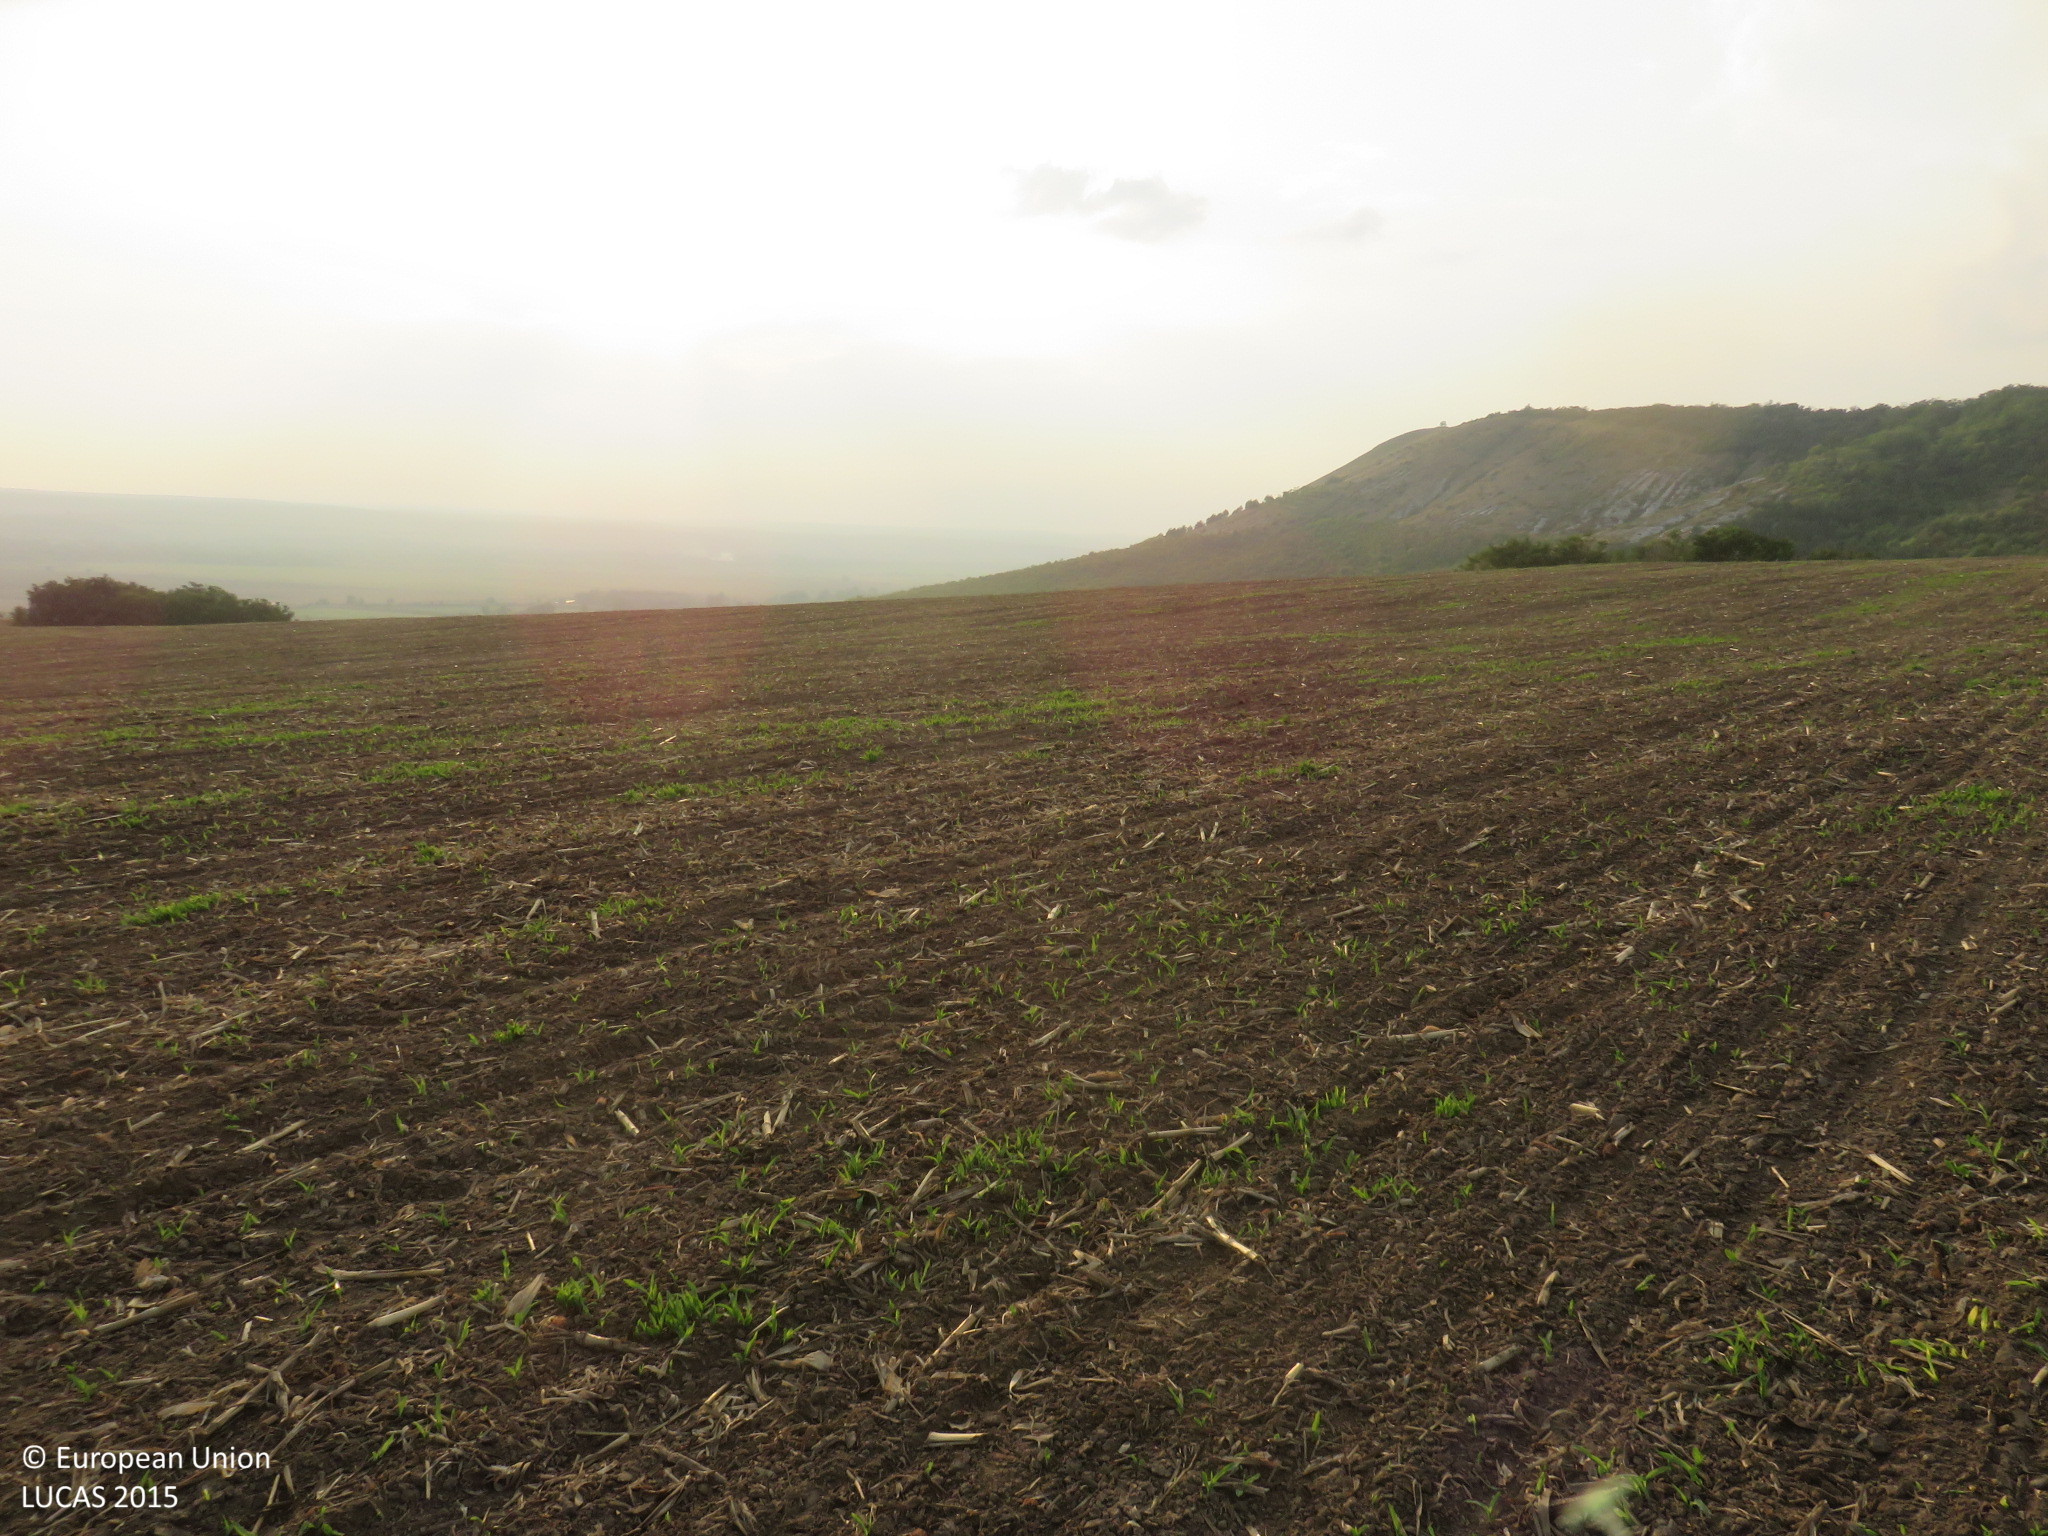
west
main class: Cropland
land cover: Maize
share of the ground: < 10 %
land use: Agriculture (excluding fallow land and kitchen gardens)
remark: Harvested field
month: September
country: BG
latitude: 43.5693
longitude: 24.9664
